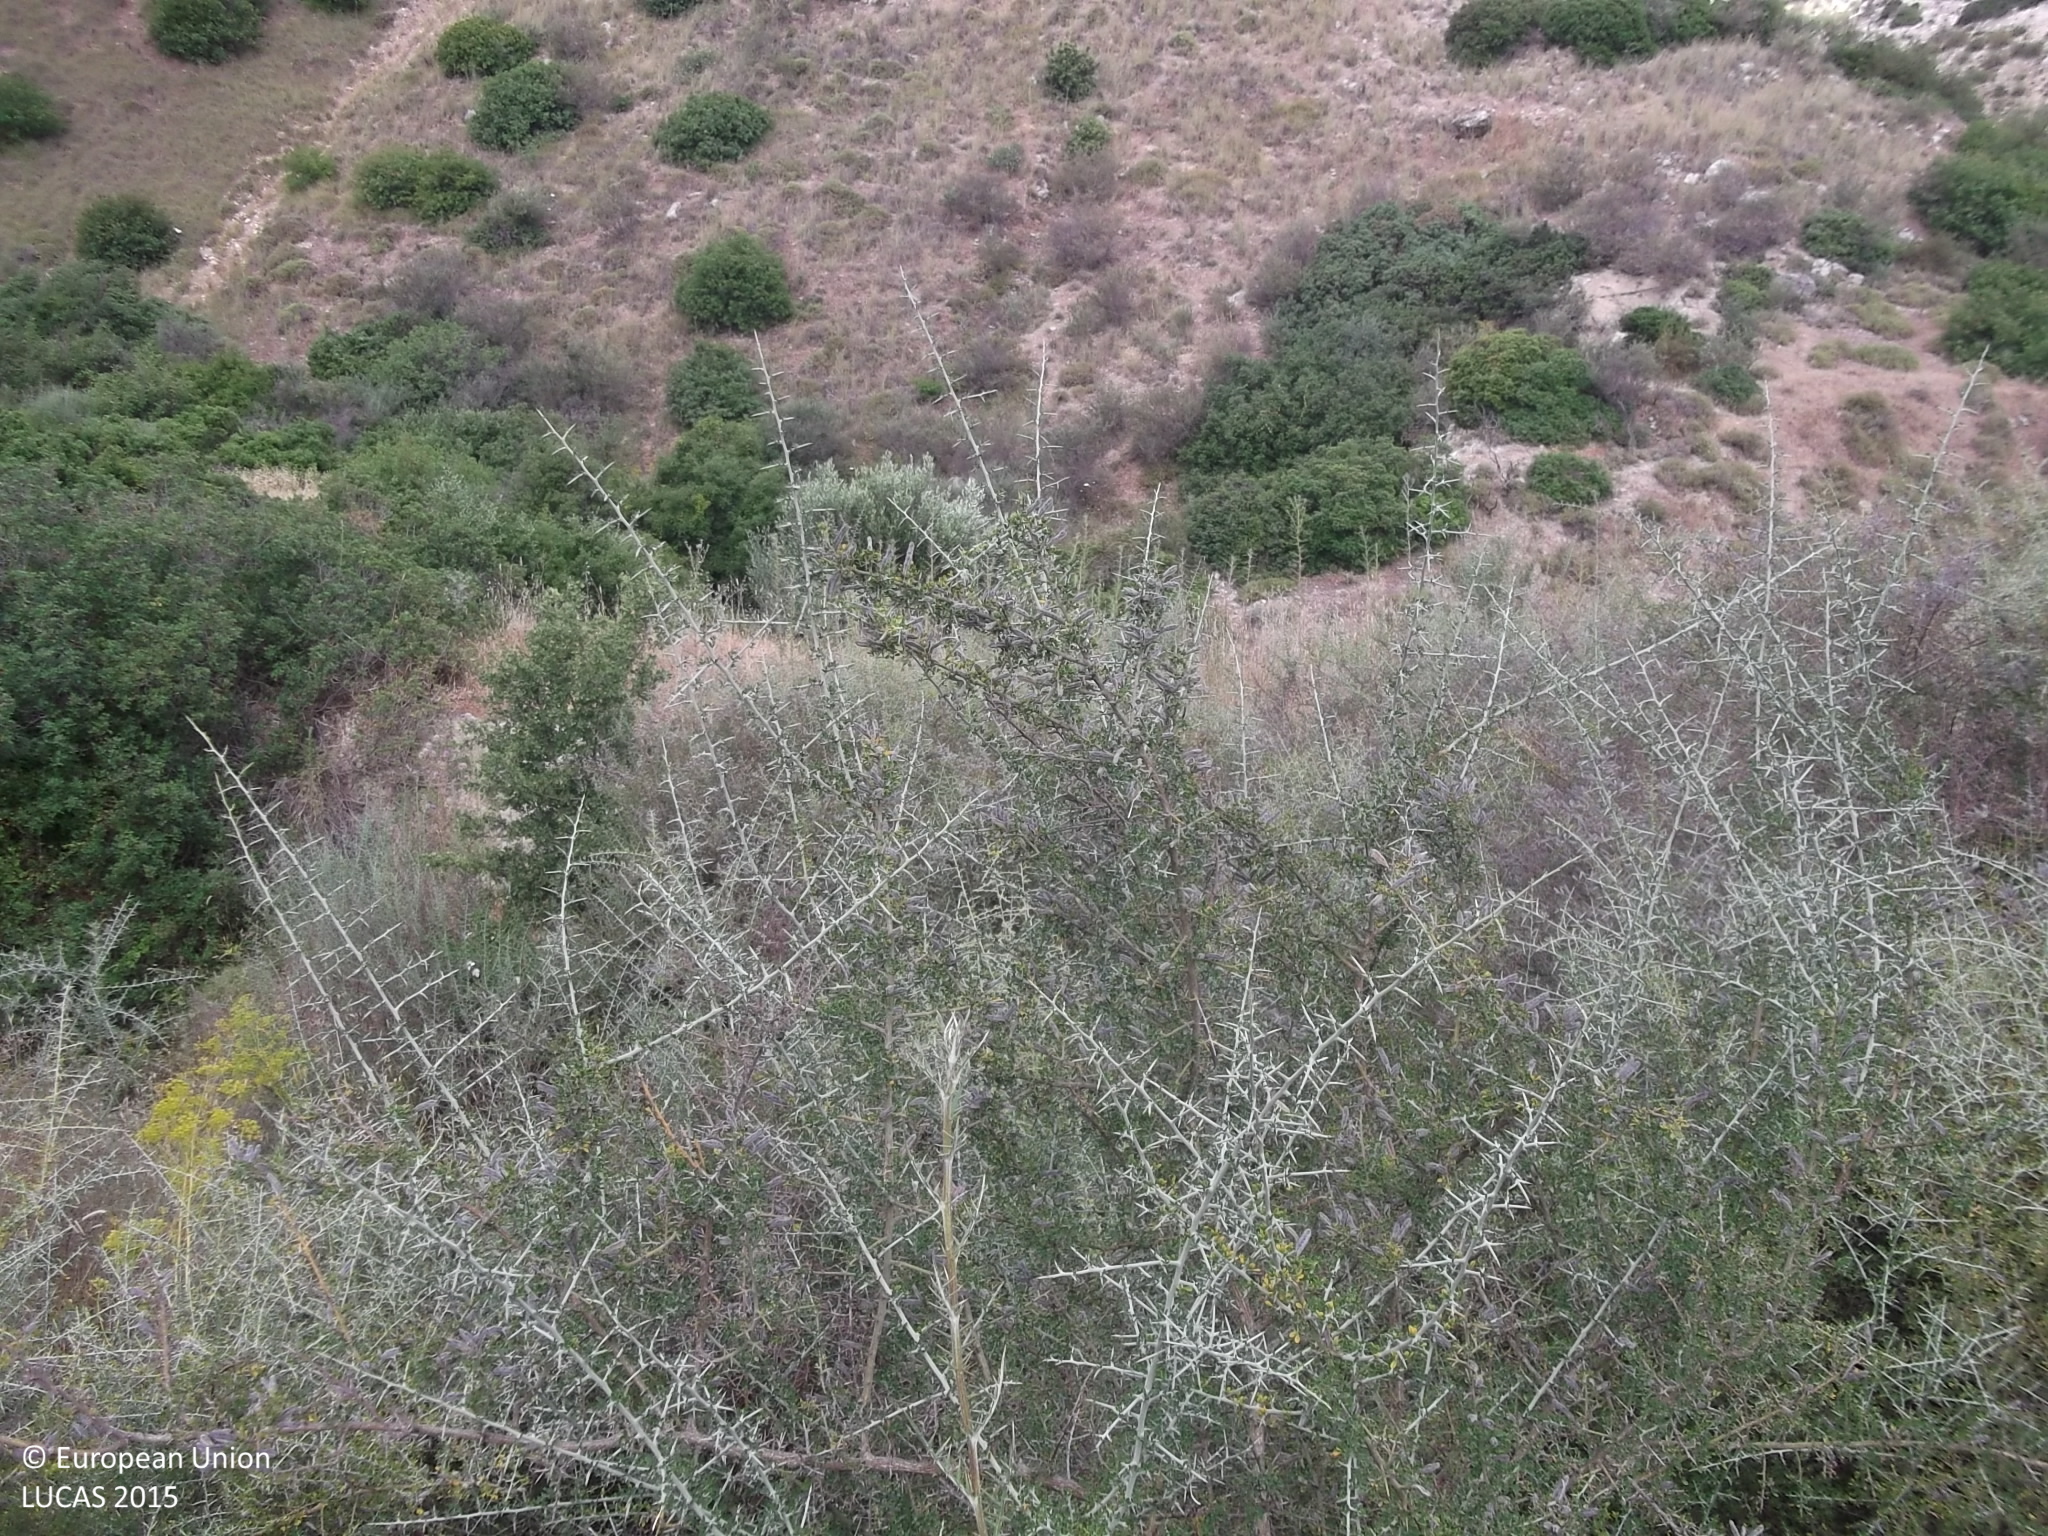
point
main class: Shrubland
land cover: Shrubland without tree cover
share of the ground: 25 - 50 %
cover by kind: herbaceous plants 55 %, shrubs 35 %, unconsolidated bare surface 10 %
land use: Semi-natural and natural areas not in use
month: May
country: CY
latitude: 34.9950
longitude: 32.4257
